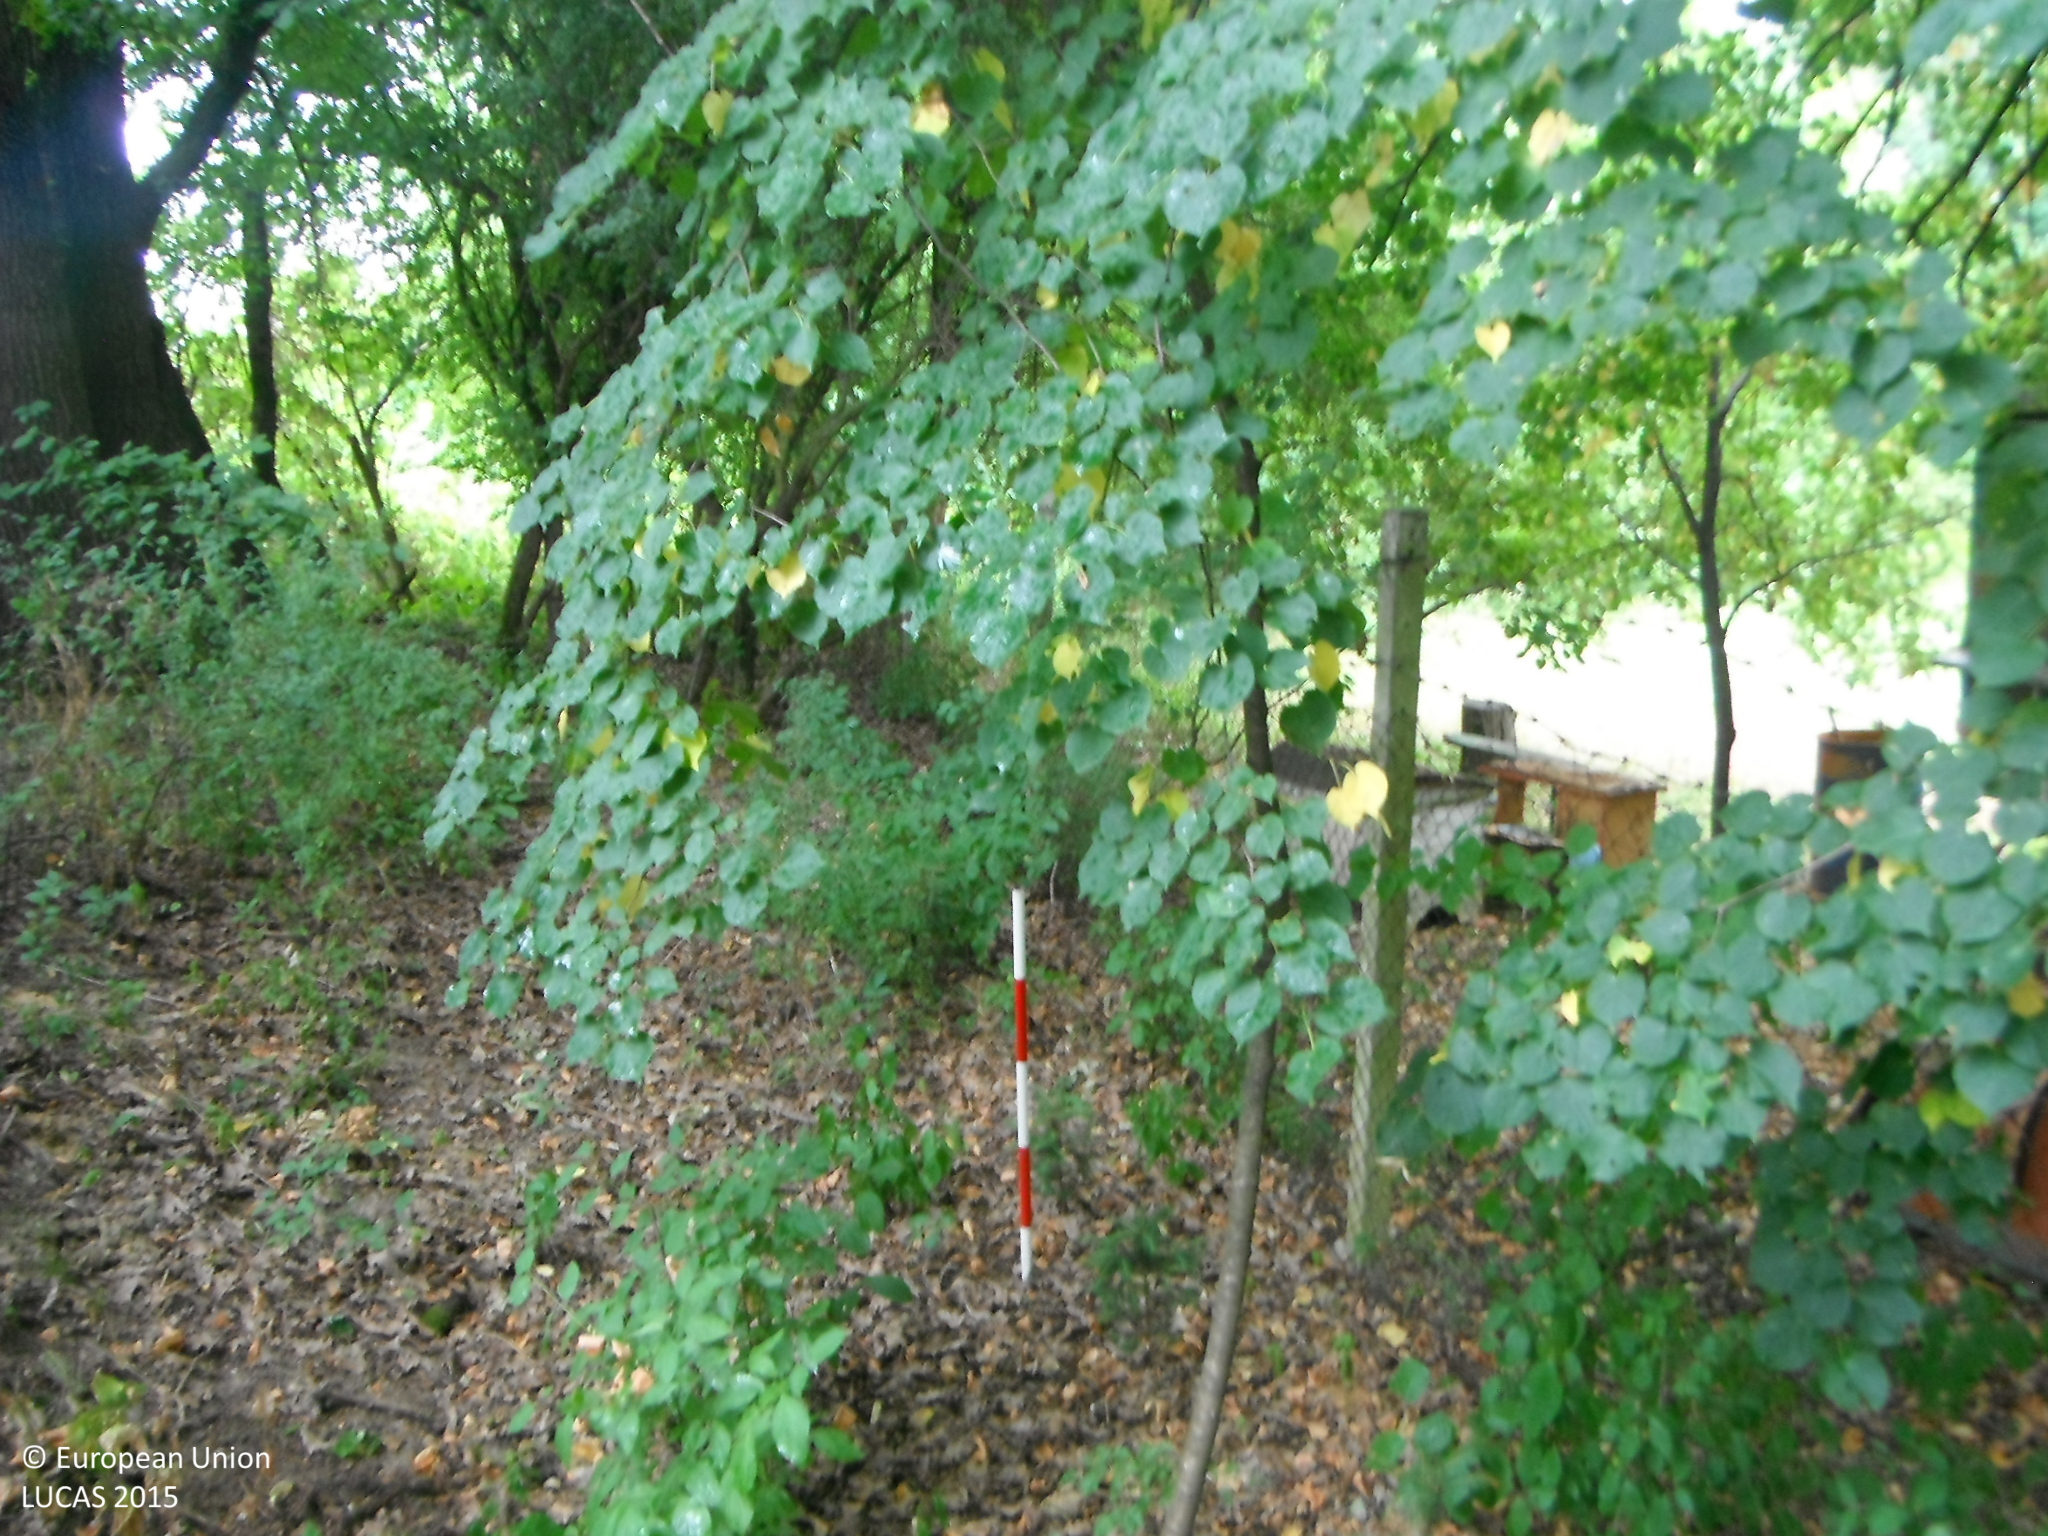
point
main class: Woodland
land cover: Broadleaved woodland
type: mesophytic deciduous forest
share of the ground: > 75 %
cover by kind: broadleaved forest trees 80 %, herbaceous plants 20 %
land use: Forestry
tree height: > 5 m
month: July
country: SK
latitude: 48.6809
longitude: 18.1505
